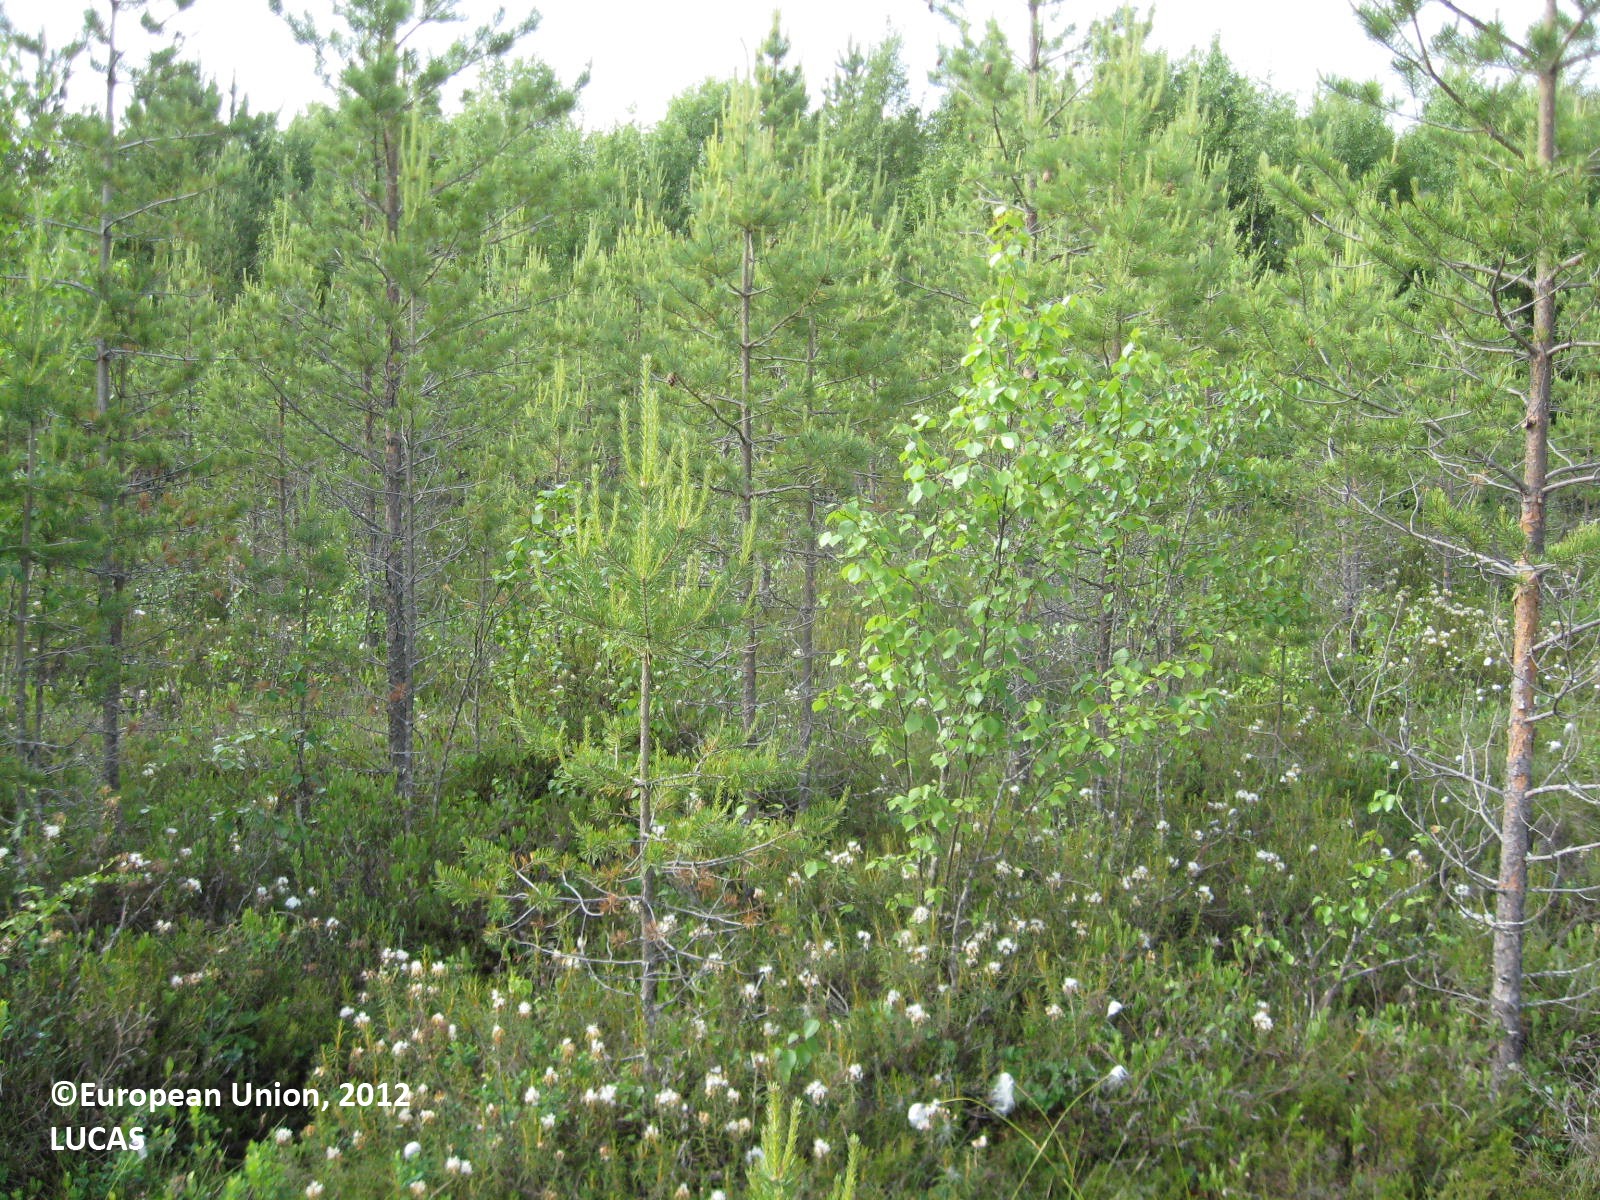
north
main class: Woodland
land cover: Pine dominated coniferous woodland
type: boreal forest
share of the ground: 50 - 75 %
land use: Forestry
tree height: > 5 m
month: June
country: FI
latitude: 63.0127
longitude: 22.8359
